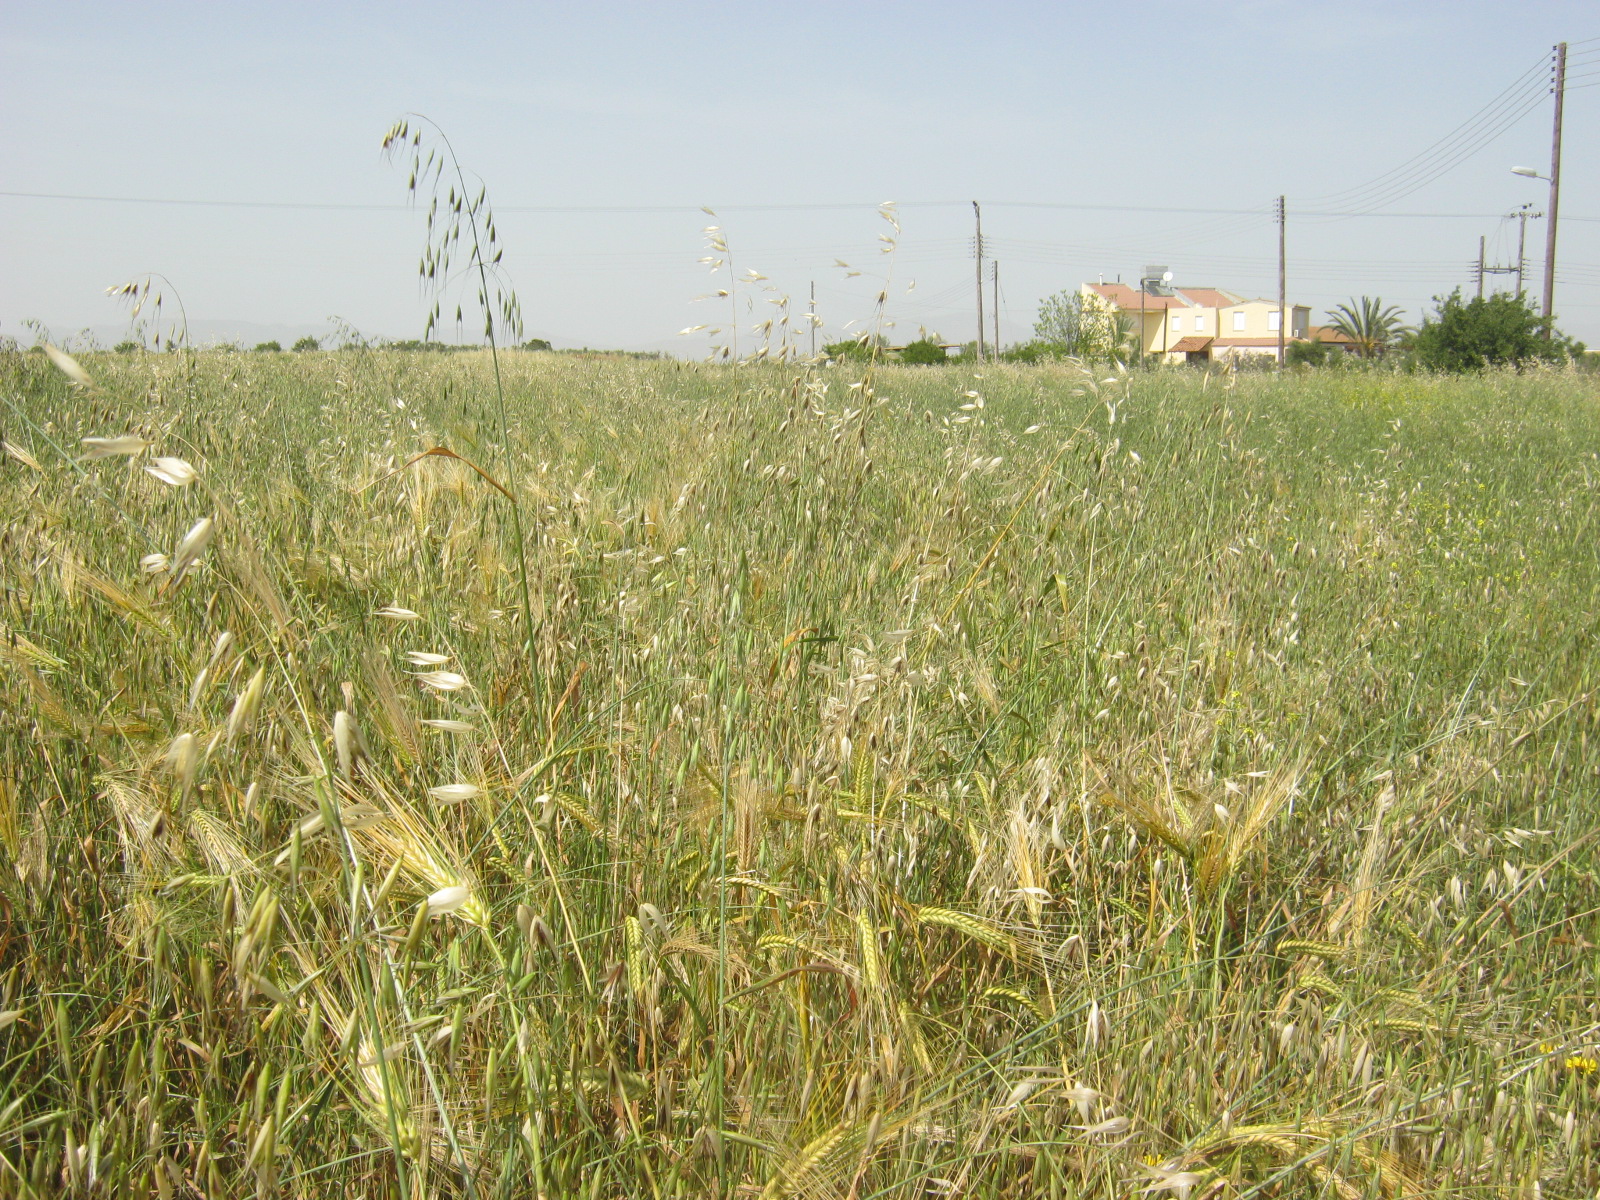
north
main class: Cropland
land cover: Mixed cereals for fodder
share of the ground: > 75 %
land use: Agriculture (excluding fallow land and kitchen gardens)
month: April
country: CY
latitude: 35.1200
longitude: 33.2642
